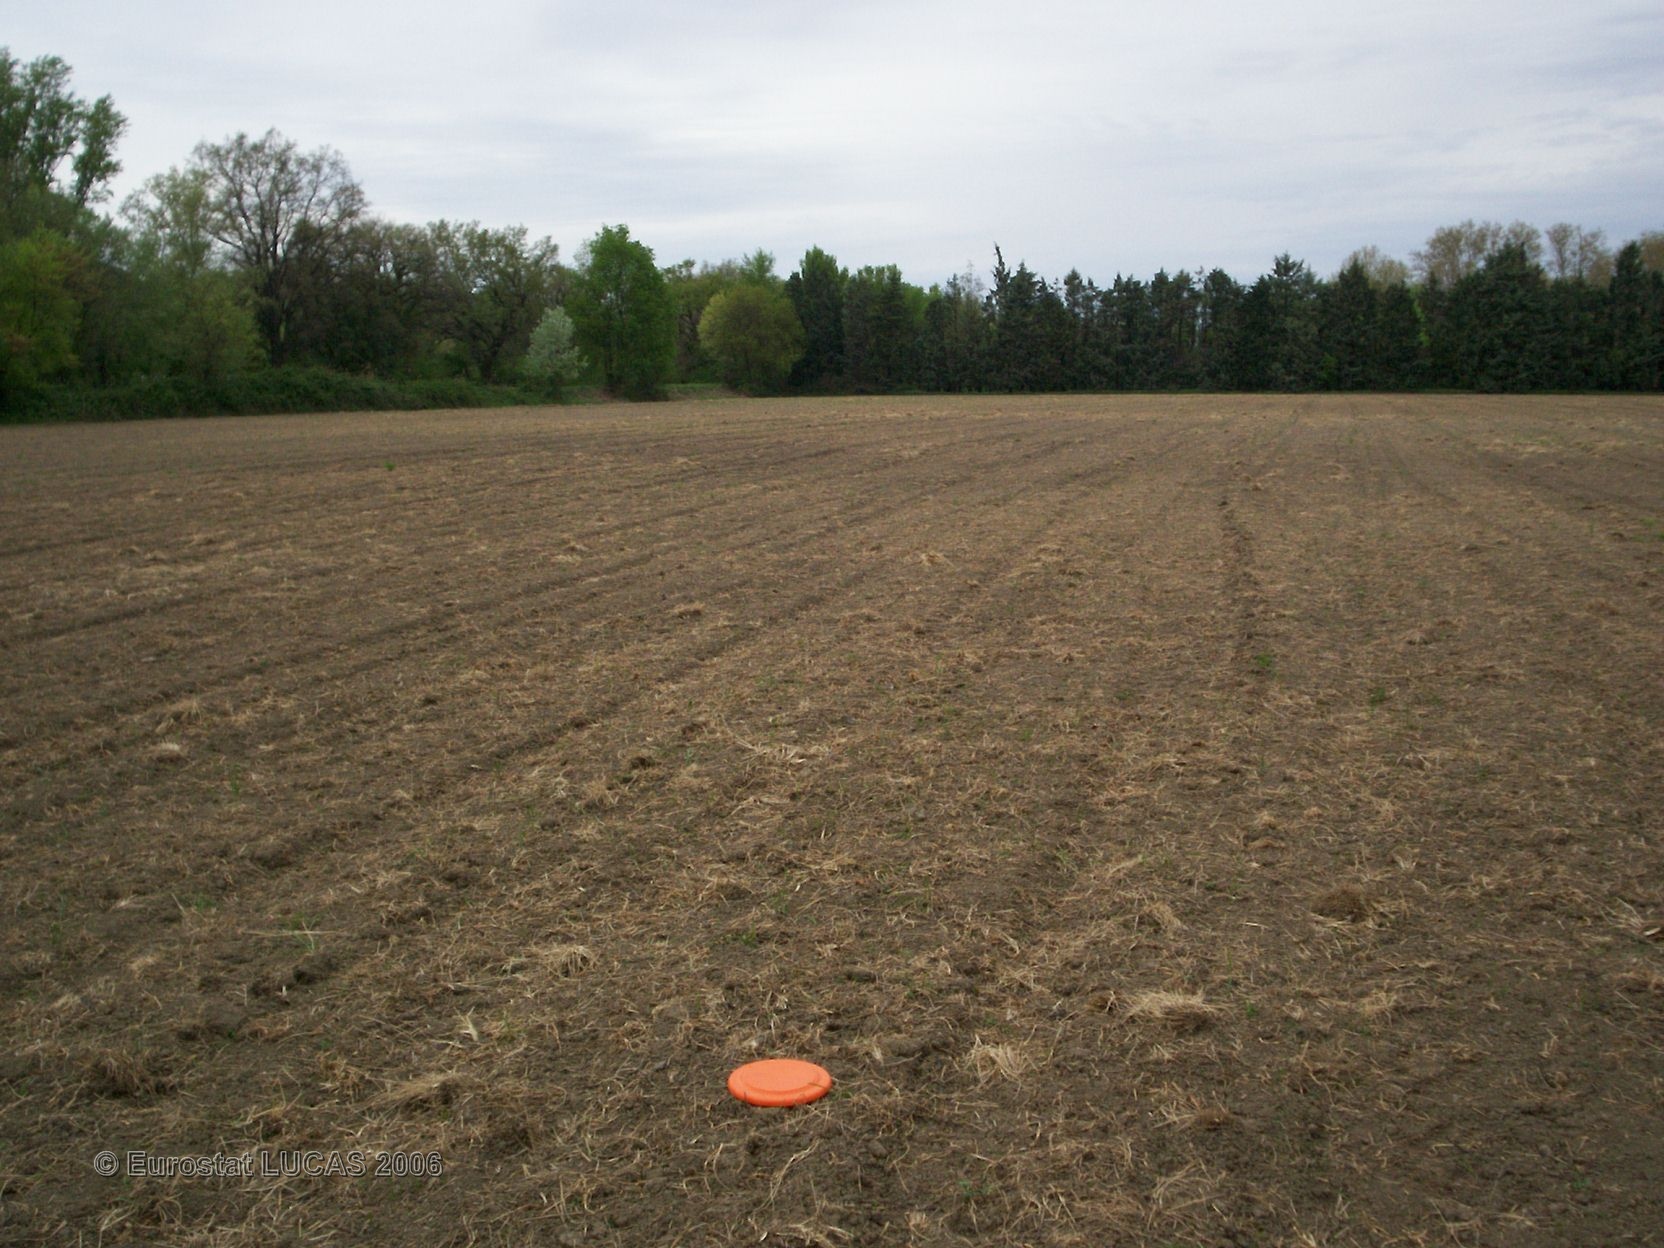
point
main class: Cropland
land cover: Lucerne
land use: Agriculture (excluding fallow land and kitchen gardens)
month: June
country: FR
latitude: 43.8455
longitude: 4.8966
